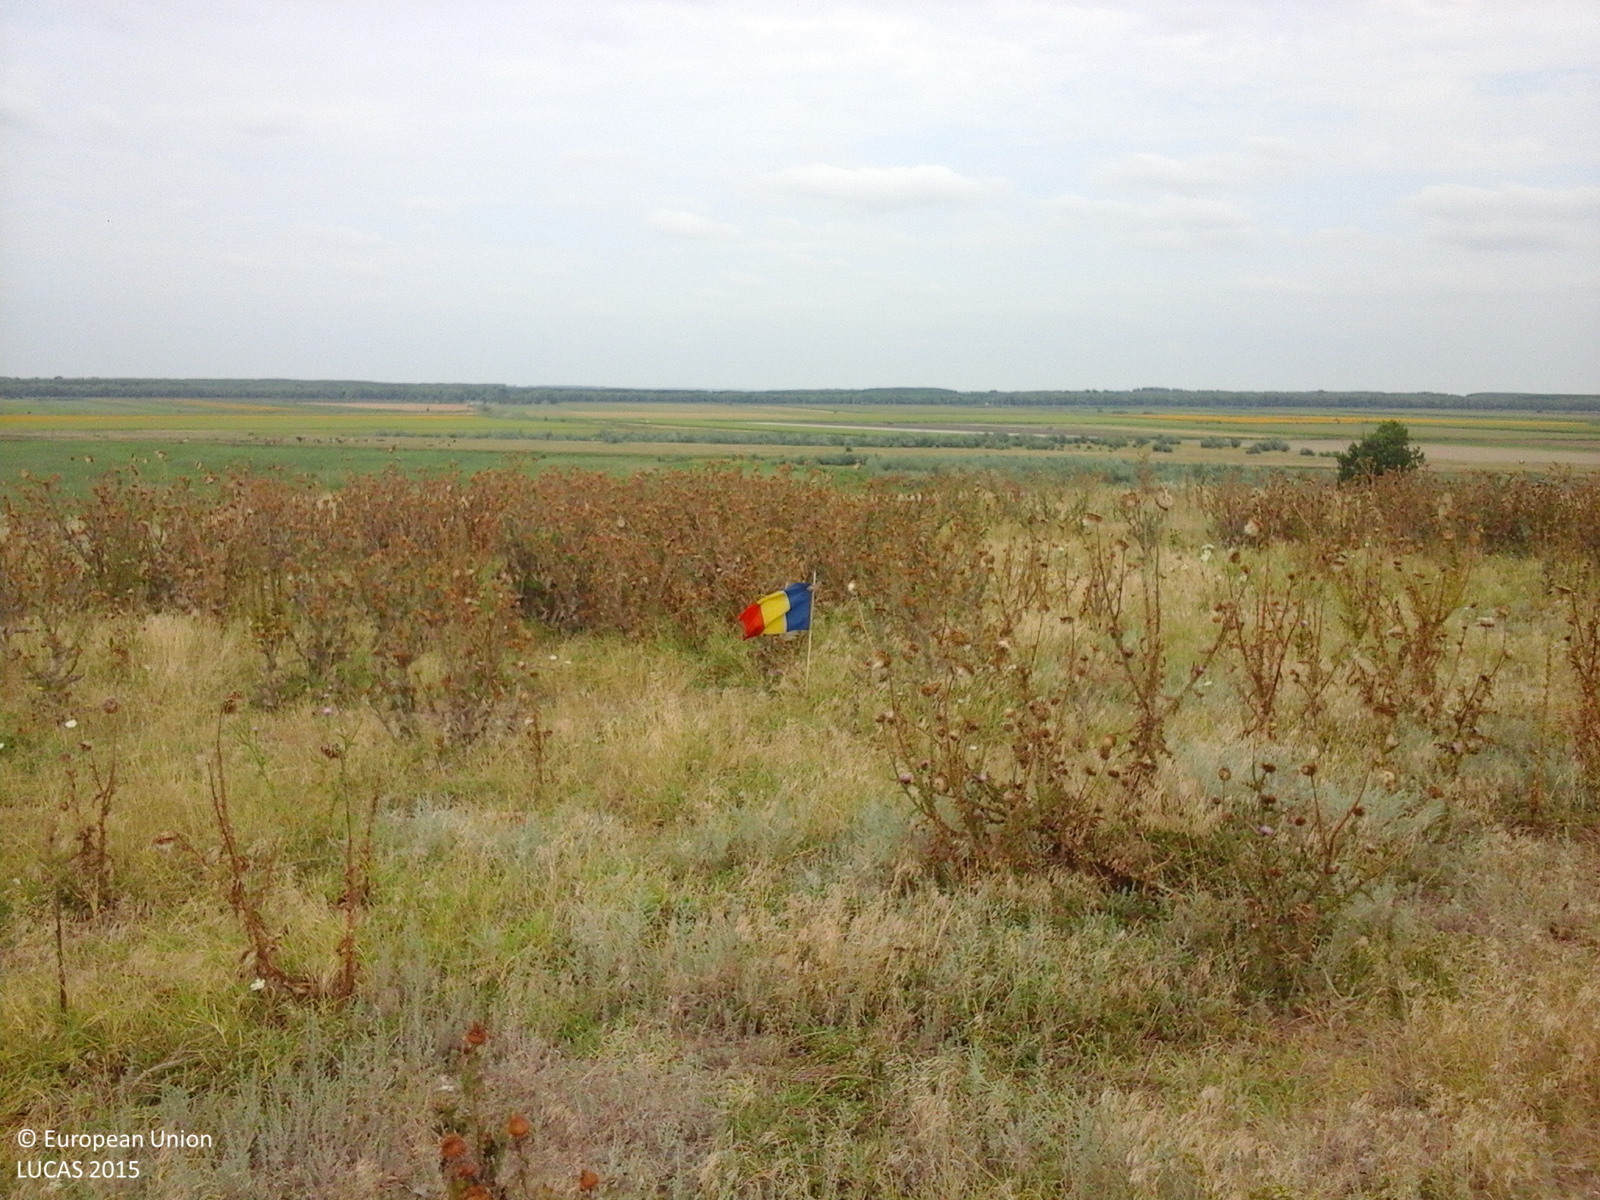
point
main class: Grassland
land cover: Spontaneously vegetated surfaces
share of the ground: > 75 %
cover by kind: herbaceous plants 100 %
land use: Fallow land
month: August
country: RO
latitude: 44.8250
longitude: 28.1118
